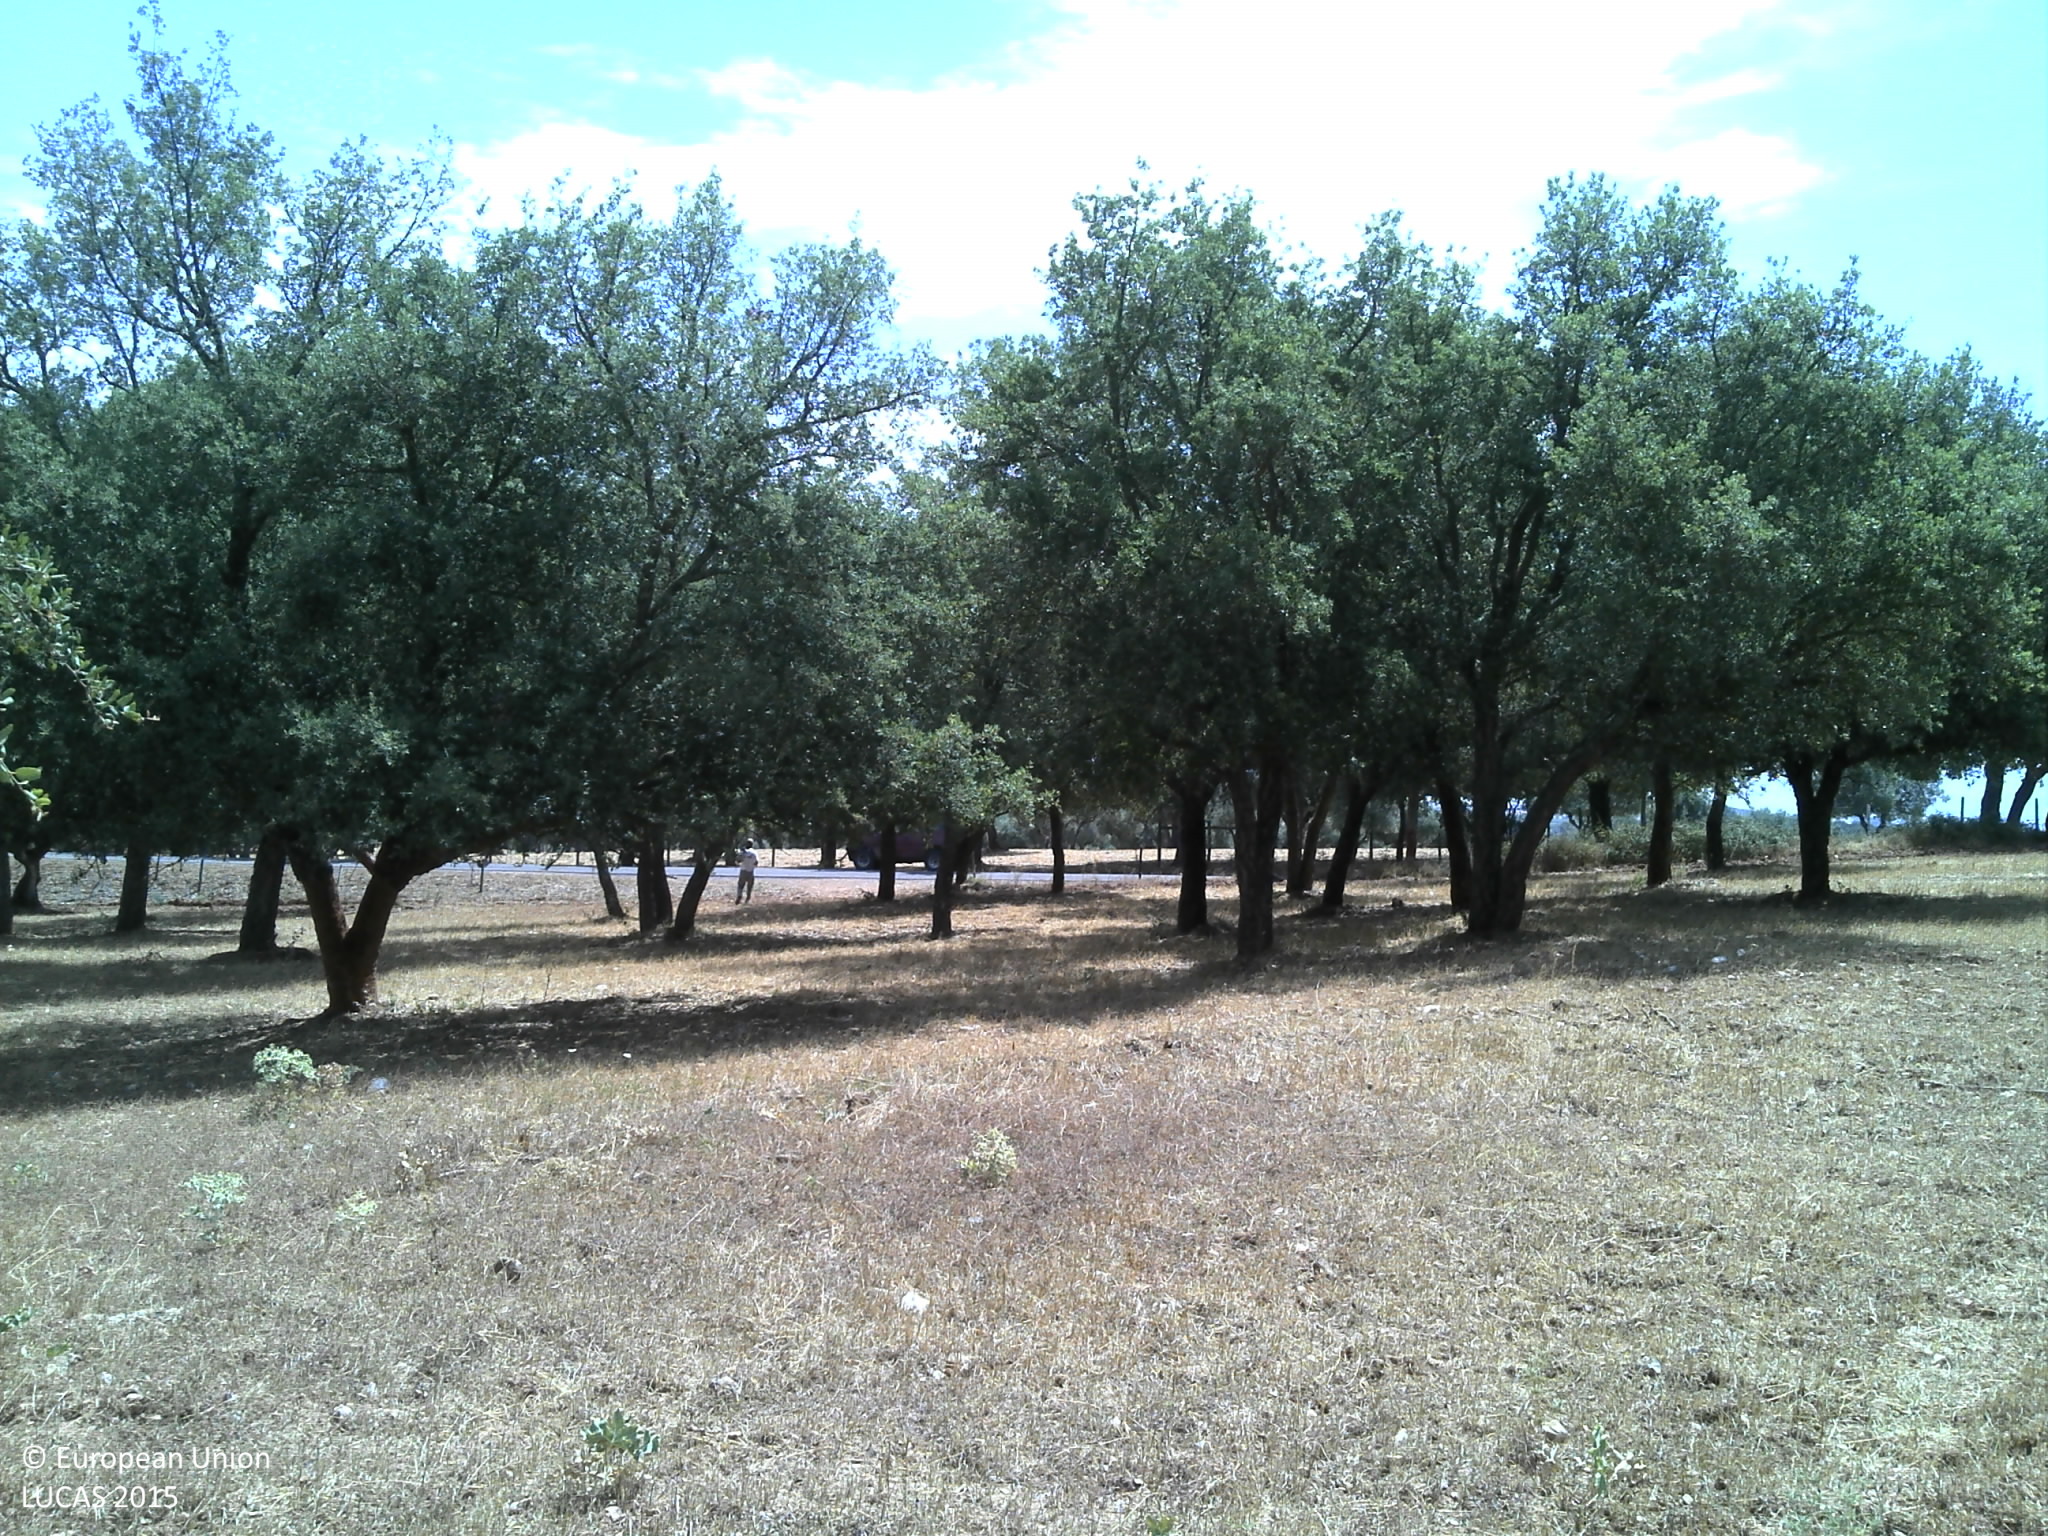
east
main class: Woodland
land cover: Broadleaved woodland
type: broadleaved evergreen forest
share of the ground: 50 - 75 %
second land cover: Olive groves
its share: 10 - 25 %
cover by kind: broadleaved forest trees 50 %, herbaceous plants 25 %, unconsolidated bare surface 25 %
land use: Forestry
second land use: Agriculture (excluding fallow land and kitchen gardens)
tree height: > 5 m
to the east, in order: Broadleaved woodland; Olive groves; Broadleaved woodland; Other bare soil; Fences; Grass margins; Paved roads, cycling and walking lanes; Grass margins; Abandoned hedges; Fences; Abandoned hedges; Olive groves; Electric lines; Olive groves; Fences; Olive groves
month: July
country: PT
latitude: 38.8443
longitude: -7.5133
